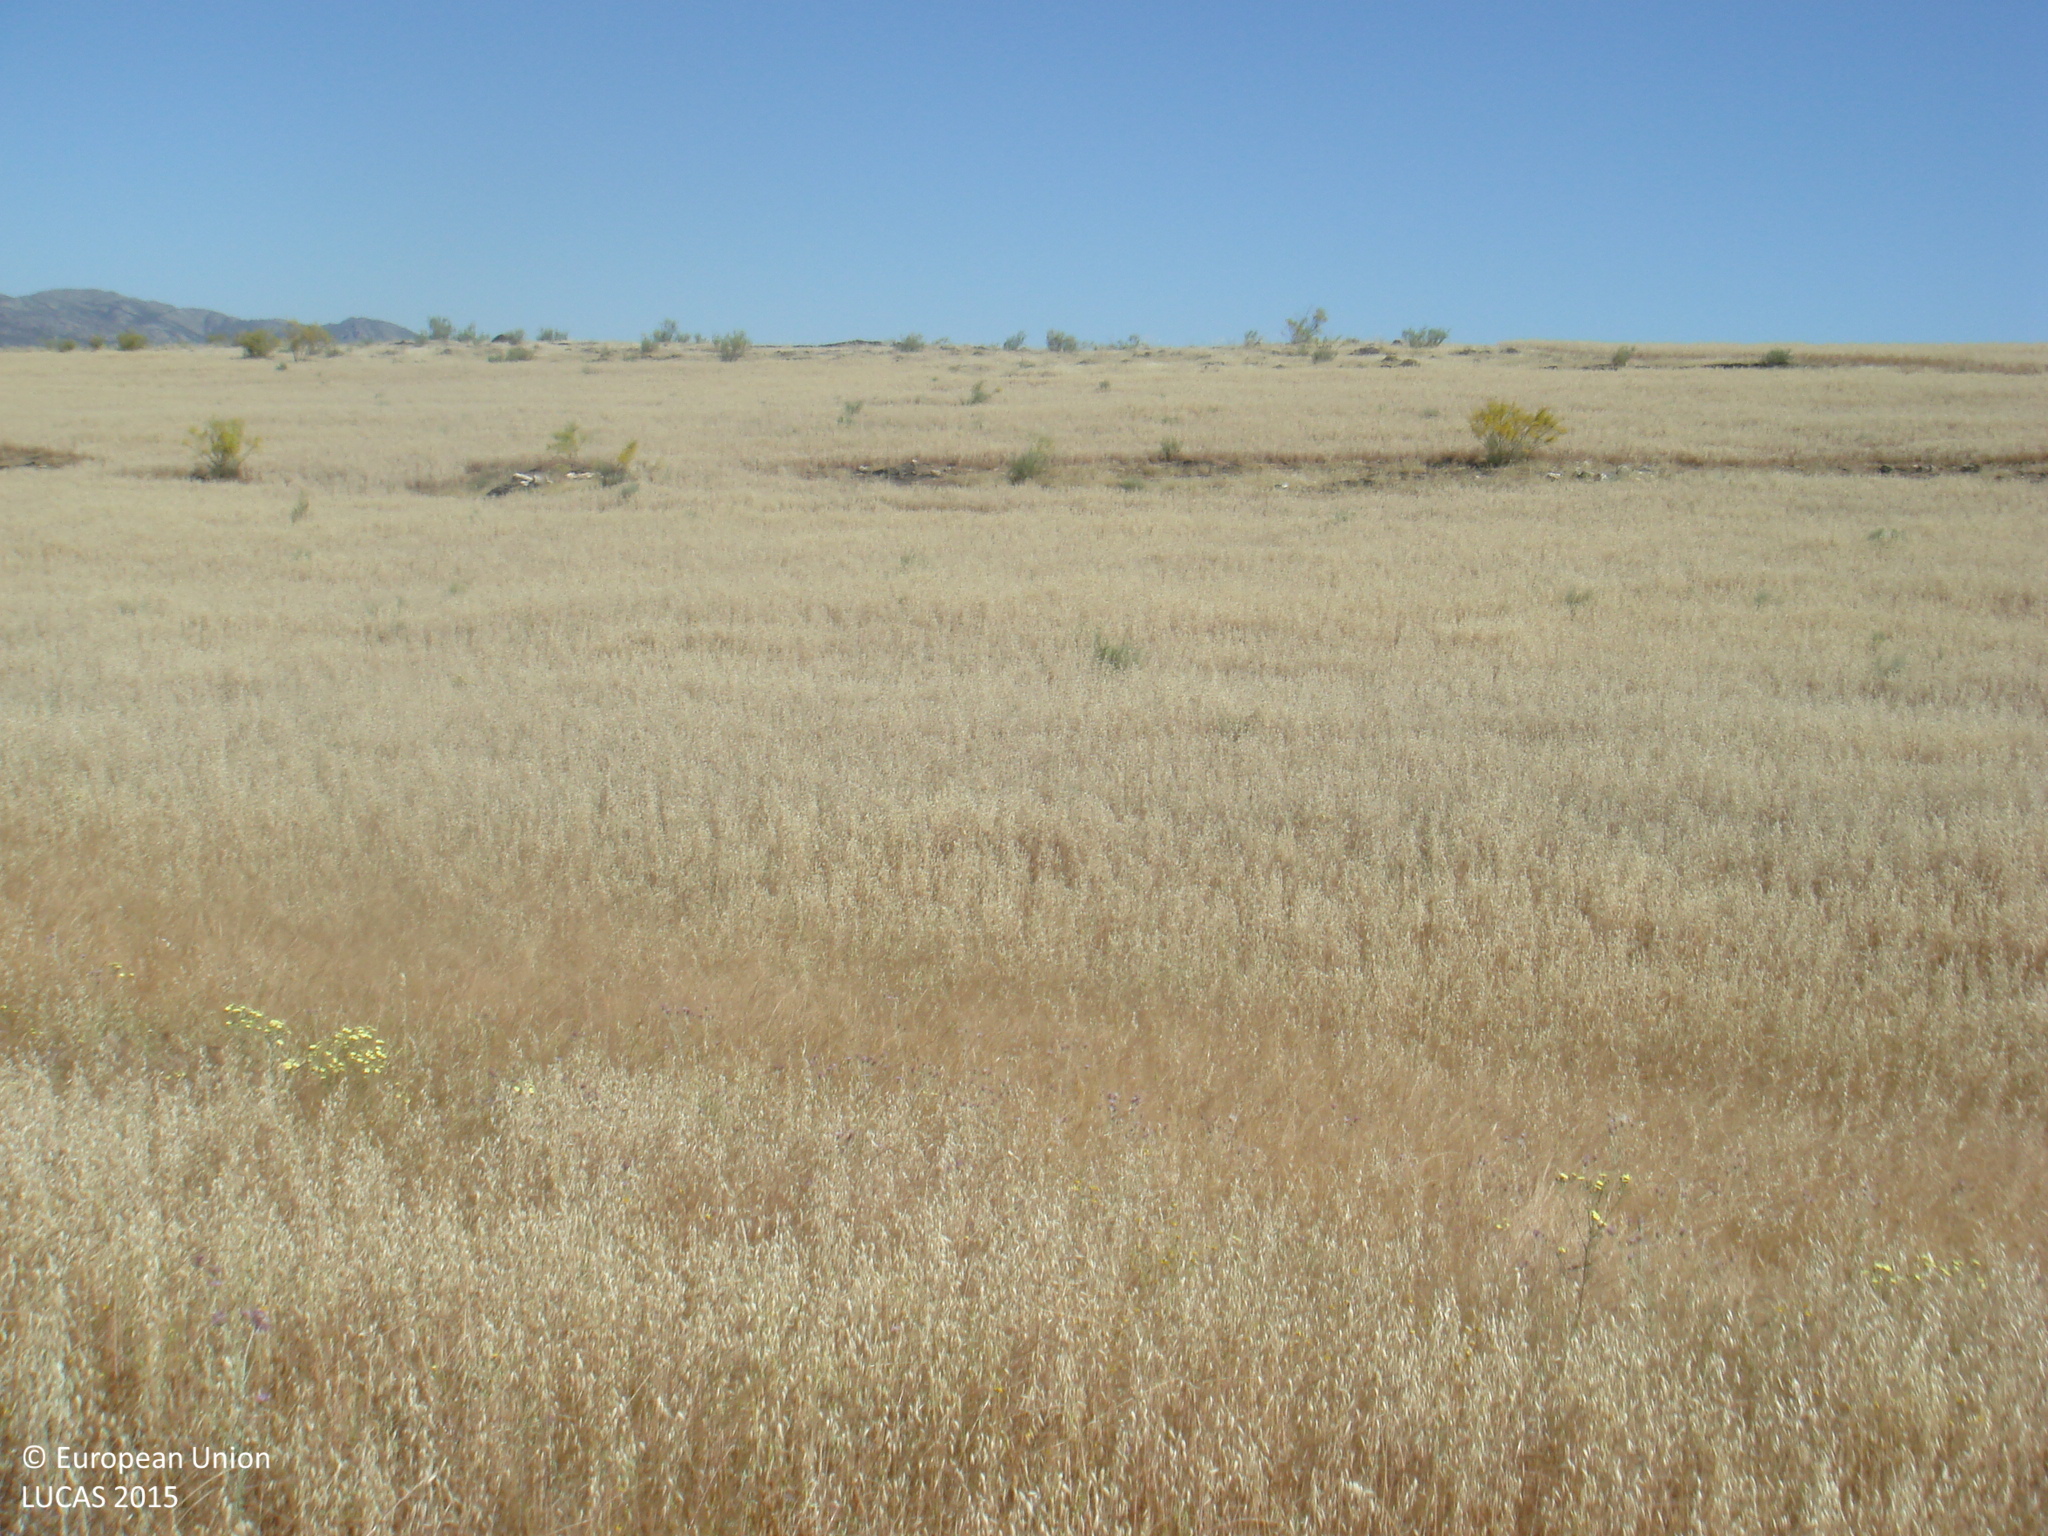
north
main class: Cropland
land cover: Oats
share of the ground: 50 - 75 %
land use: Agriculture (excluding fallow land and kitchen gardens)
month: May
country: ES
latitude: 38.6400
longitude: -5.1630
